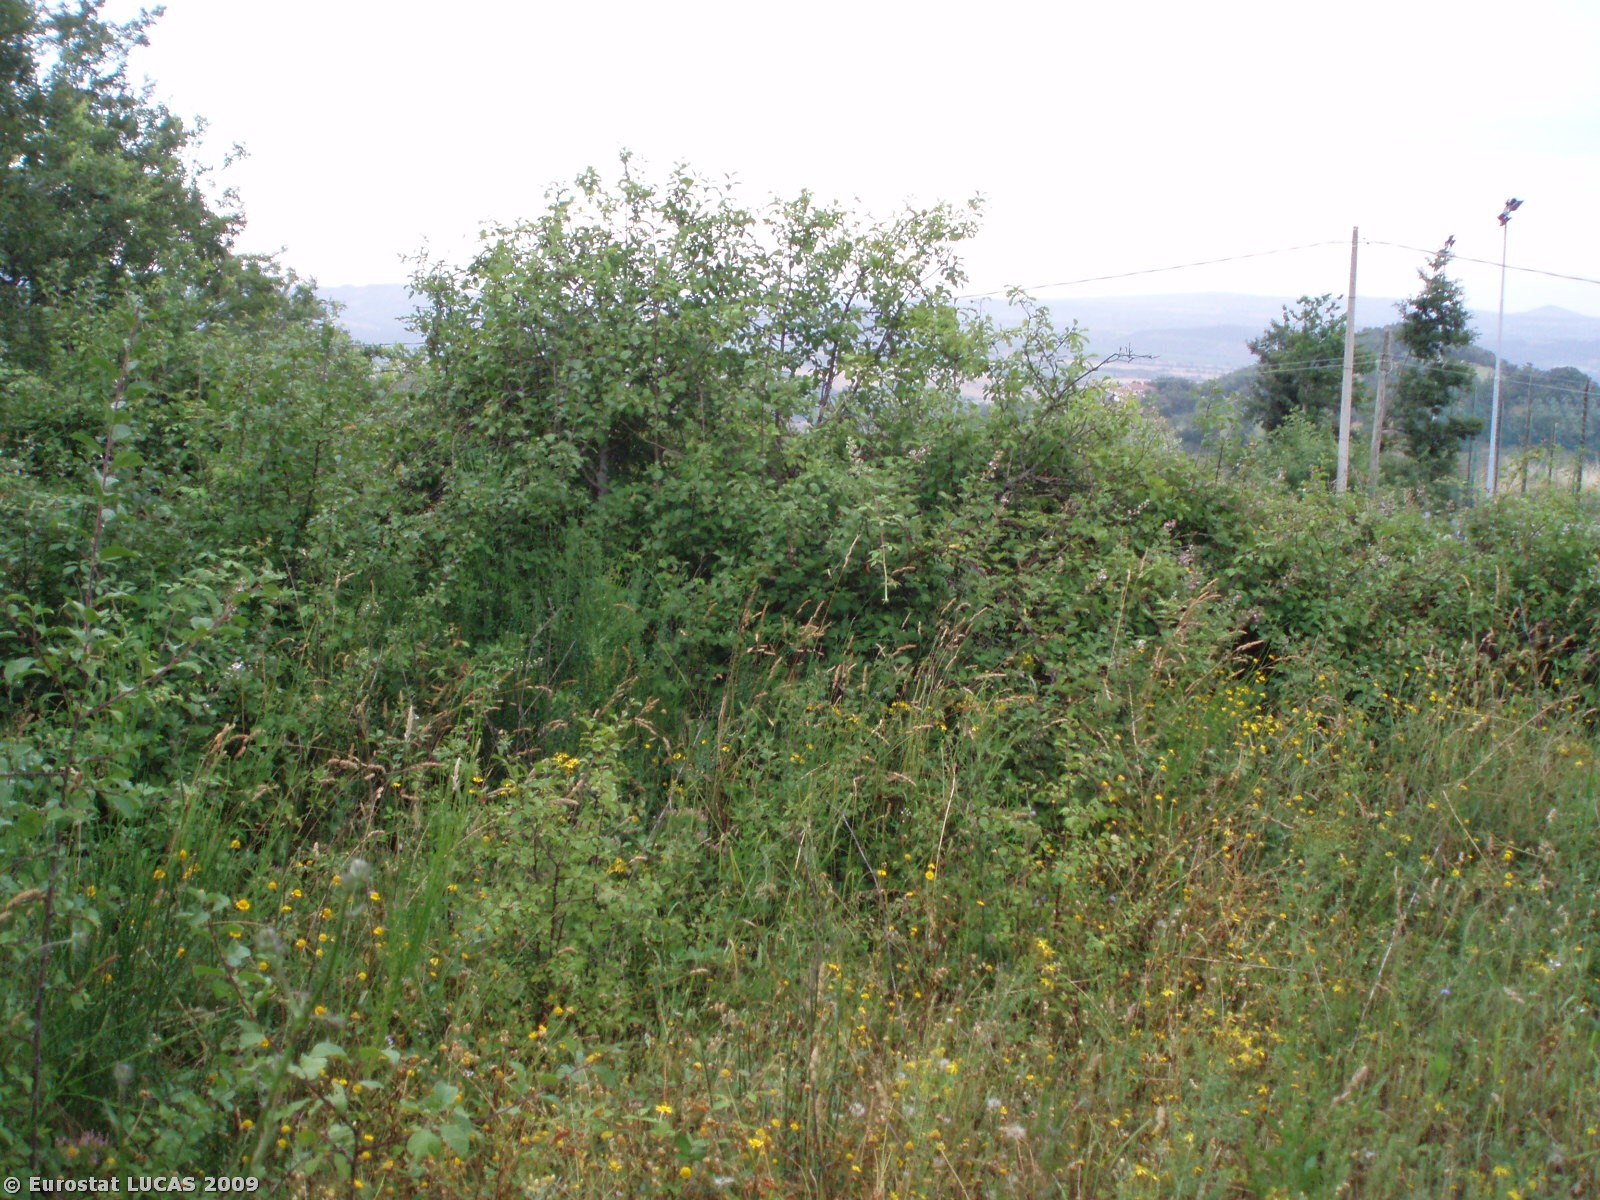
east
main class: Shrubland
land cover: Shrubland with sparse tree cover
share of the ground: > 75 %
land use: Fallow land
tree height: > 5 m
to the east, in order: Shrubland with sparse tree cover; Grass margins; Paved roads, cycling and walking lanes; Fences; Olive groves; Grassland with sparse tree/shrub cover; Broadleaved woodland; Grassland without tree/shrub cover
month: June
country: IT
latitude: 42.6776
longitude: 11.5934
